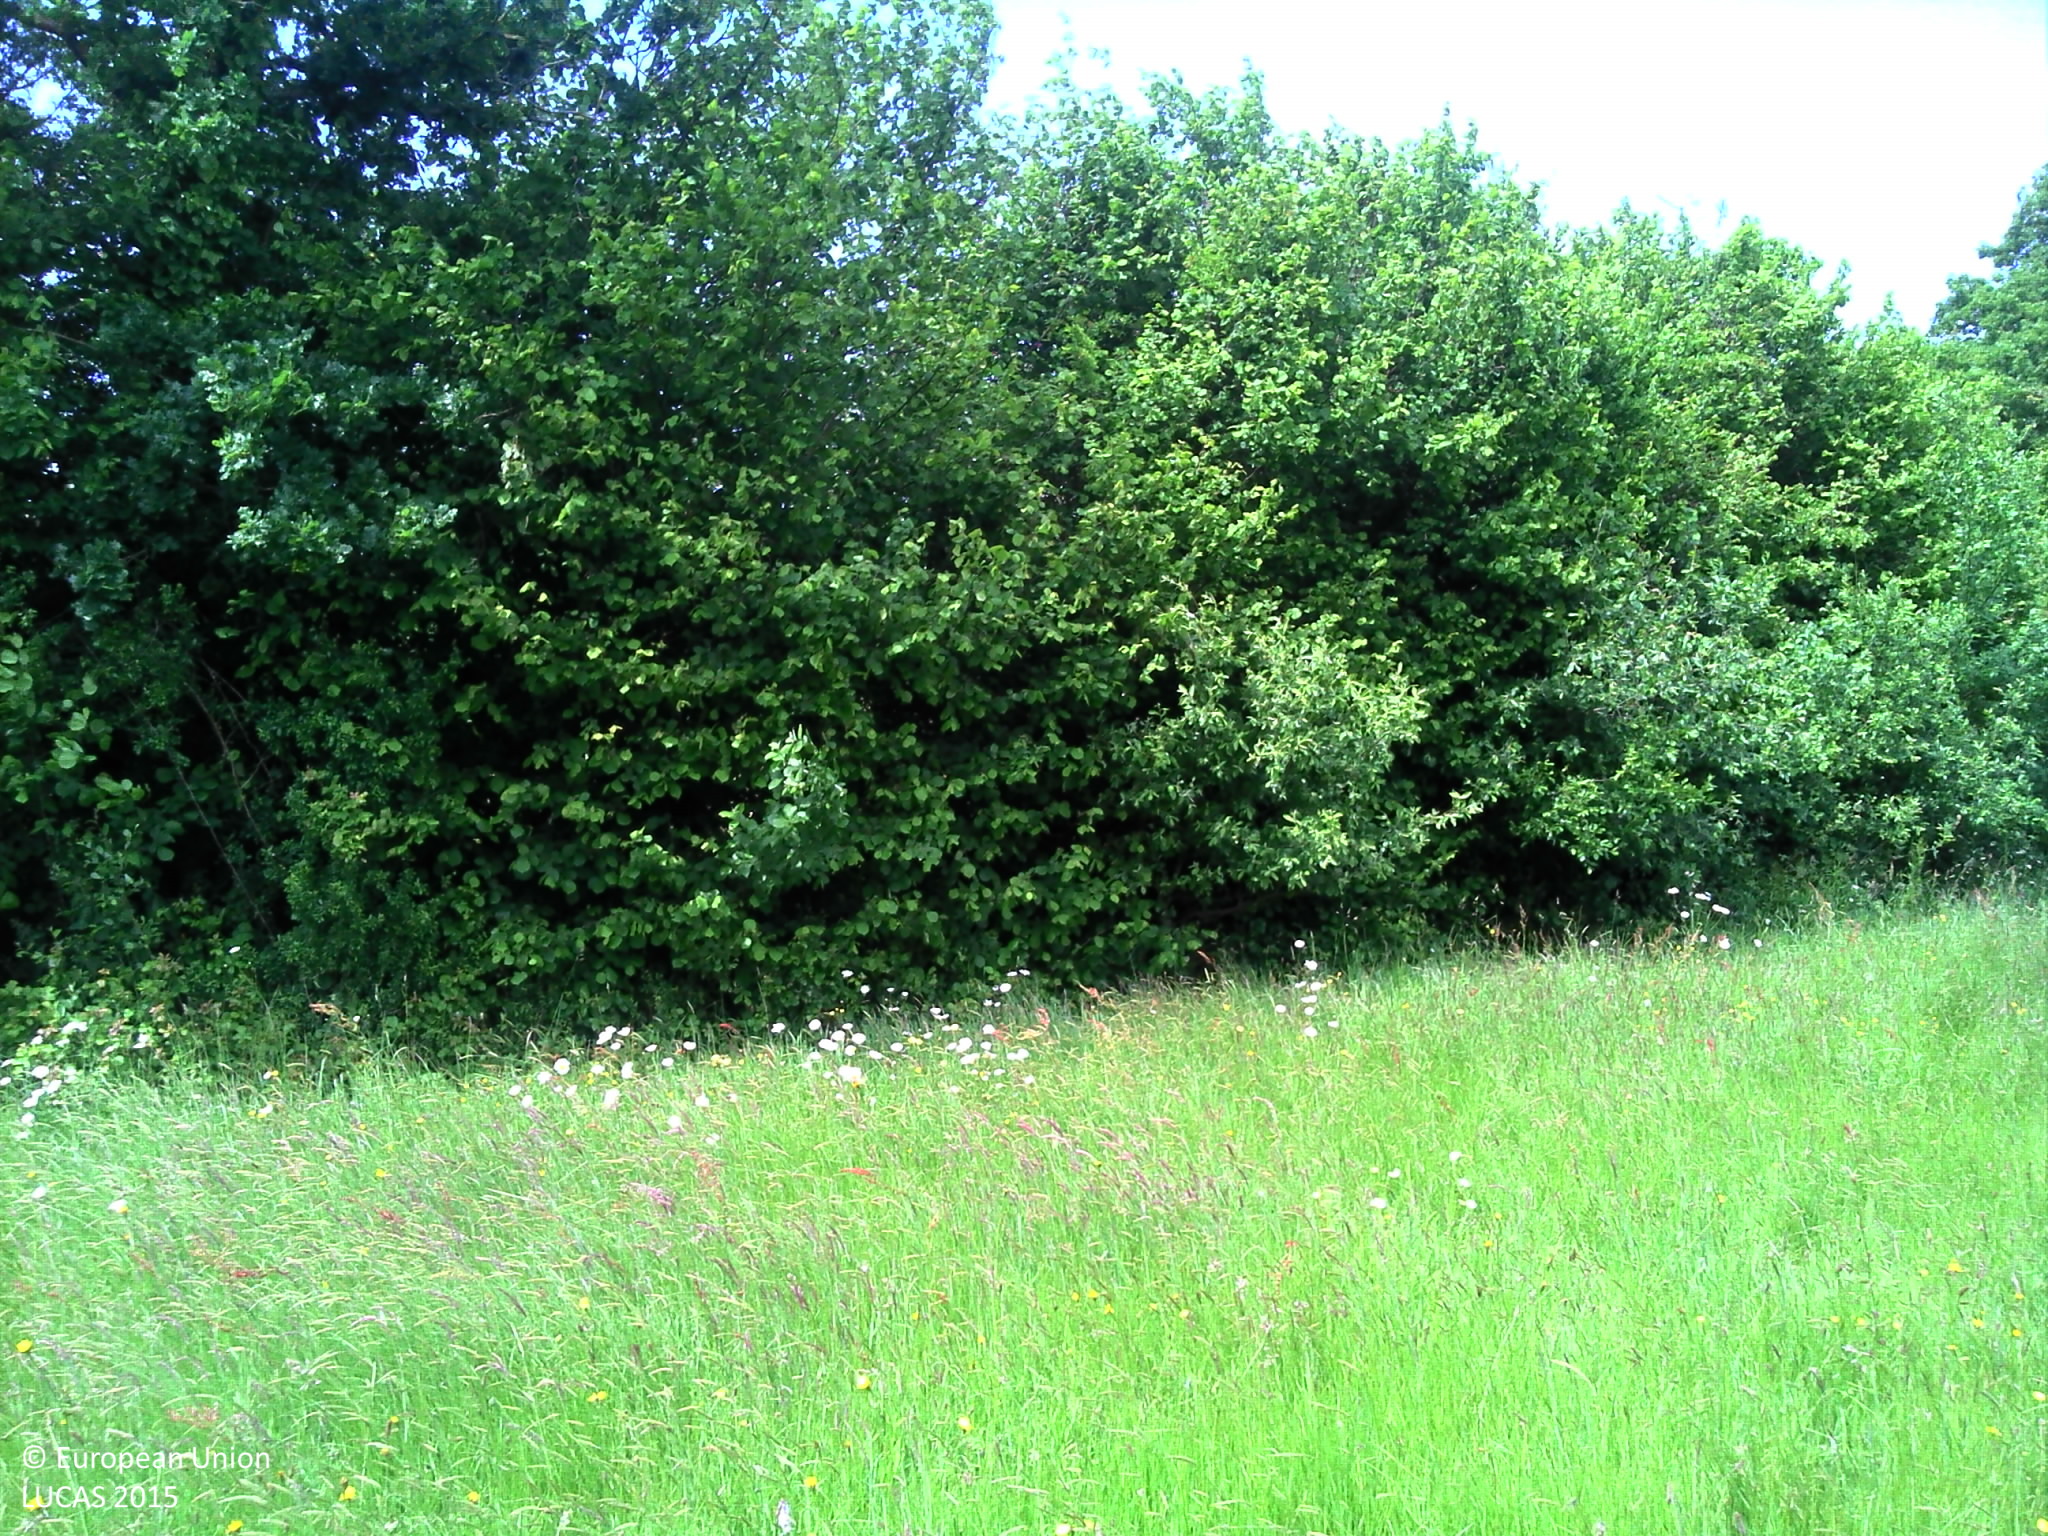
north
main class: Grassland
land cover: Grassland without tree/shrub cover
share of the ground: > 75 %
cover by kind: herbaceous plants 100 %
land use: Agriculture (excluding fallow land and kitchen gardens)
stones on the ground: < 10 %
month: June
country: FR
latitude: 49.4945
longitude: -1.4669
